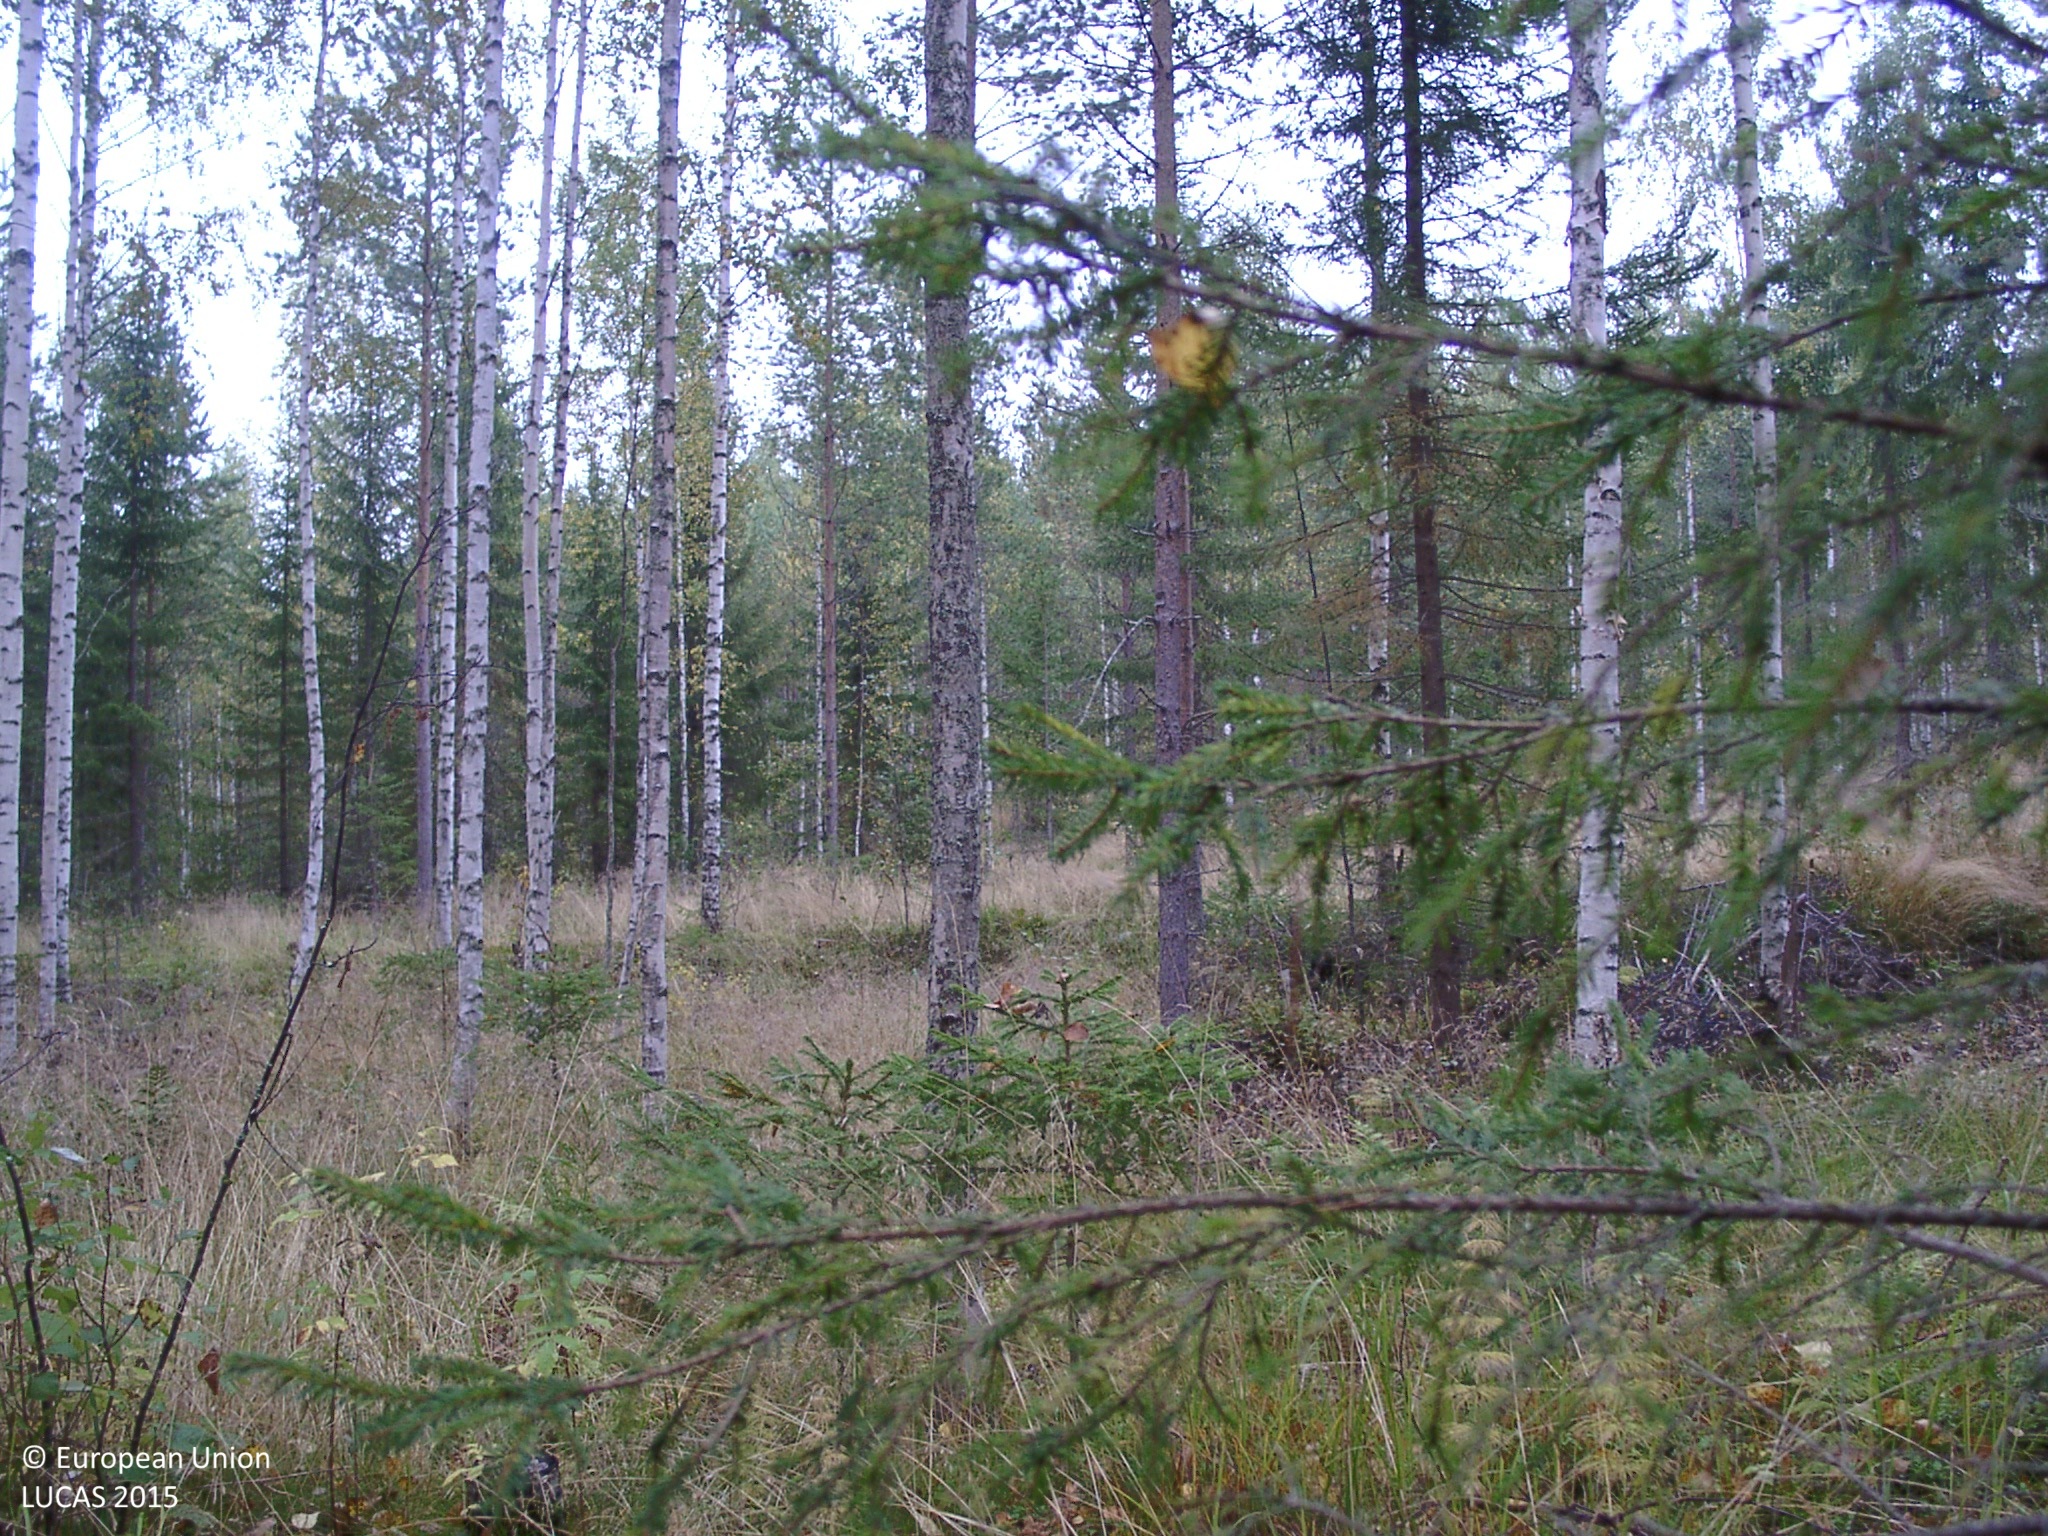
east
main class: Woodland
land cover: Pine dominated mixed woodland
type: boreal forest
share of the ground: 50 - 75 %
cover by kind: coniferous forest trees 45 %, herbaceous plants 30 %, broadleaved forest trees 25 %
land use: Forestry
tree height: > 5 m
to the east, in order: Ditches and canals; Broadleaved woodland; Other mixed woodland; Ditches and canals; Groves; Tracks; Grass margins; Ditches and canals; Other mixed woodland; Pine dominated mixed woodland; Broadleaved woodland; Other mixed woodland; Broadleaved woodland; Pine dominated coniferous woodland
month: September
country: FI
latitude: 62.7141
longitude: 25.7782
